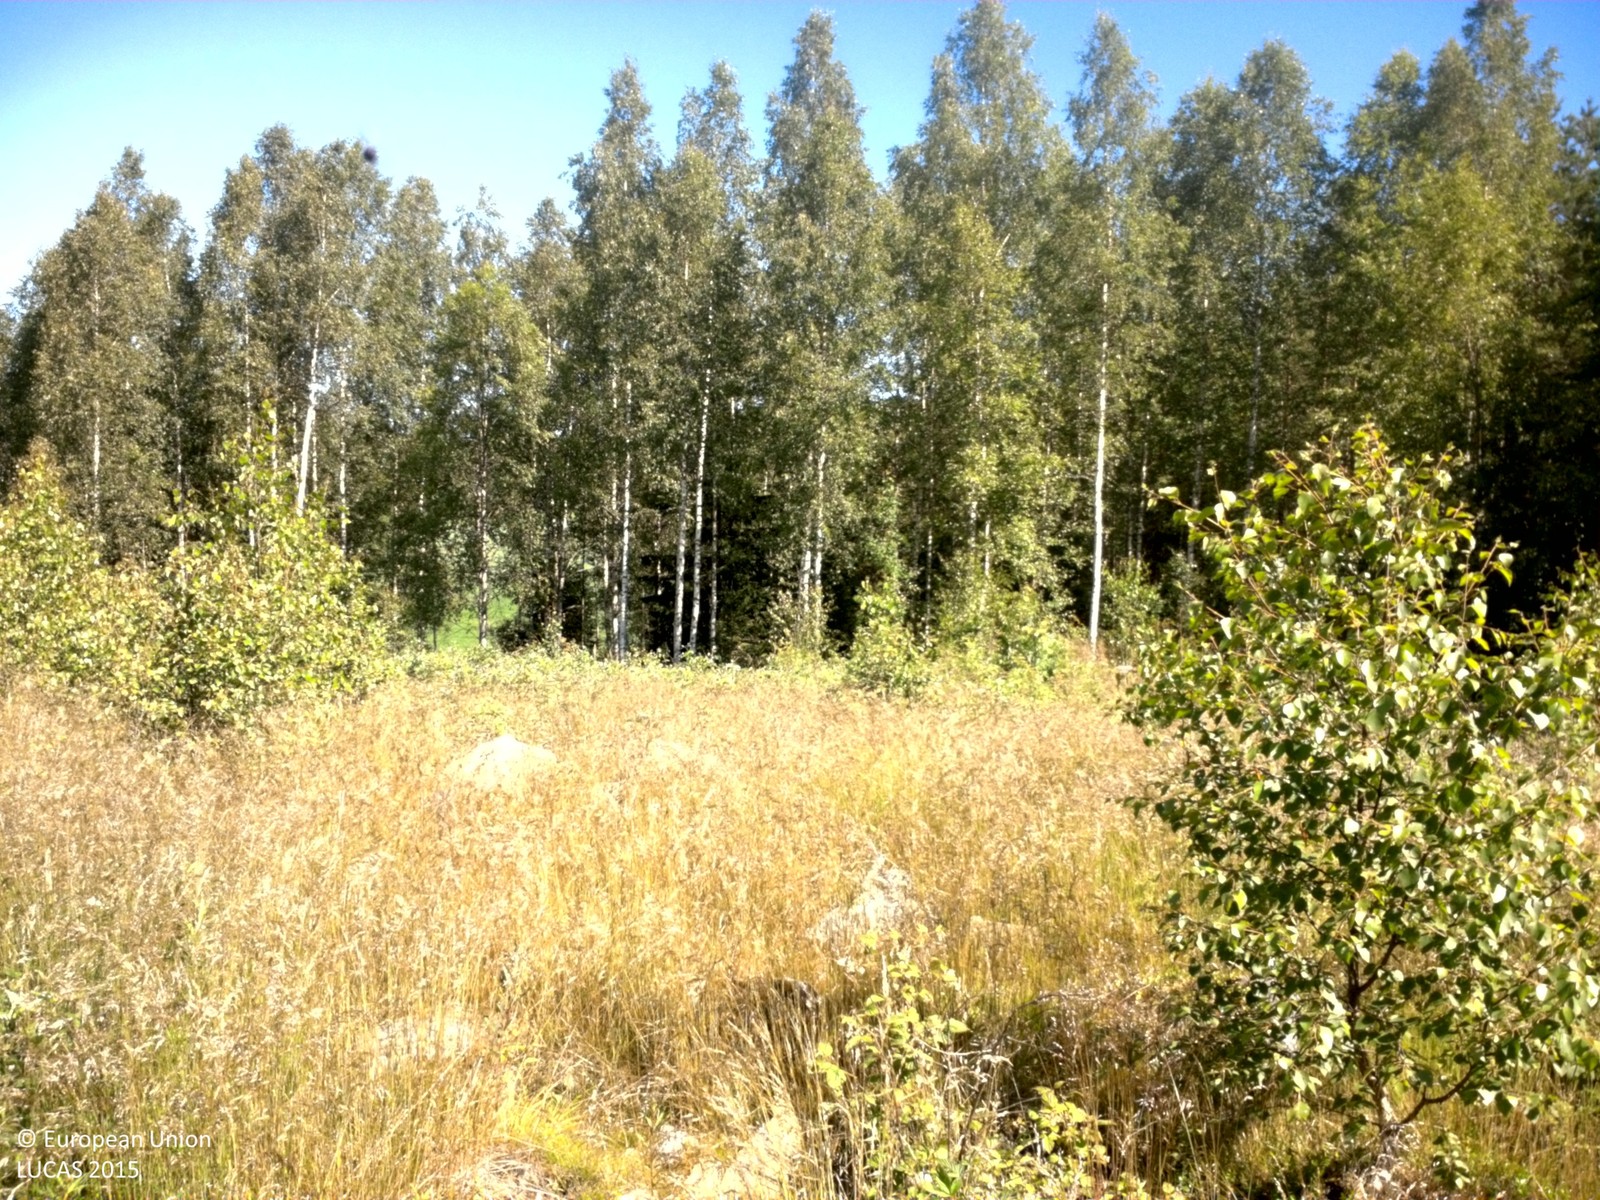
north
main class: Woodland
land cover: Broadleaved woodland
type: hemiboreal forest and nemoral coniferous forest and mixed broadleaved-coniferous forest
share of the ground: 10 - 25 %
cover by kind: herbaceous plants 70 %, broadleaved forest trees 20 %, coniferous forest trees 5 %, consolidated bare surface 5 %
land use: Forestry
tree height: < 5 m
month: July
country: SE
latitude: 60.0384
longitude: 16.7225
